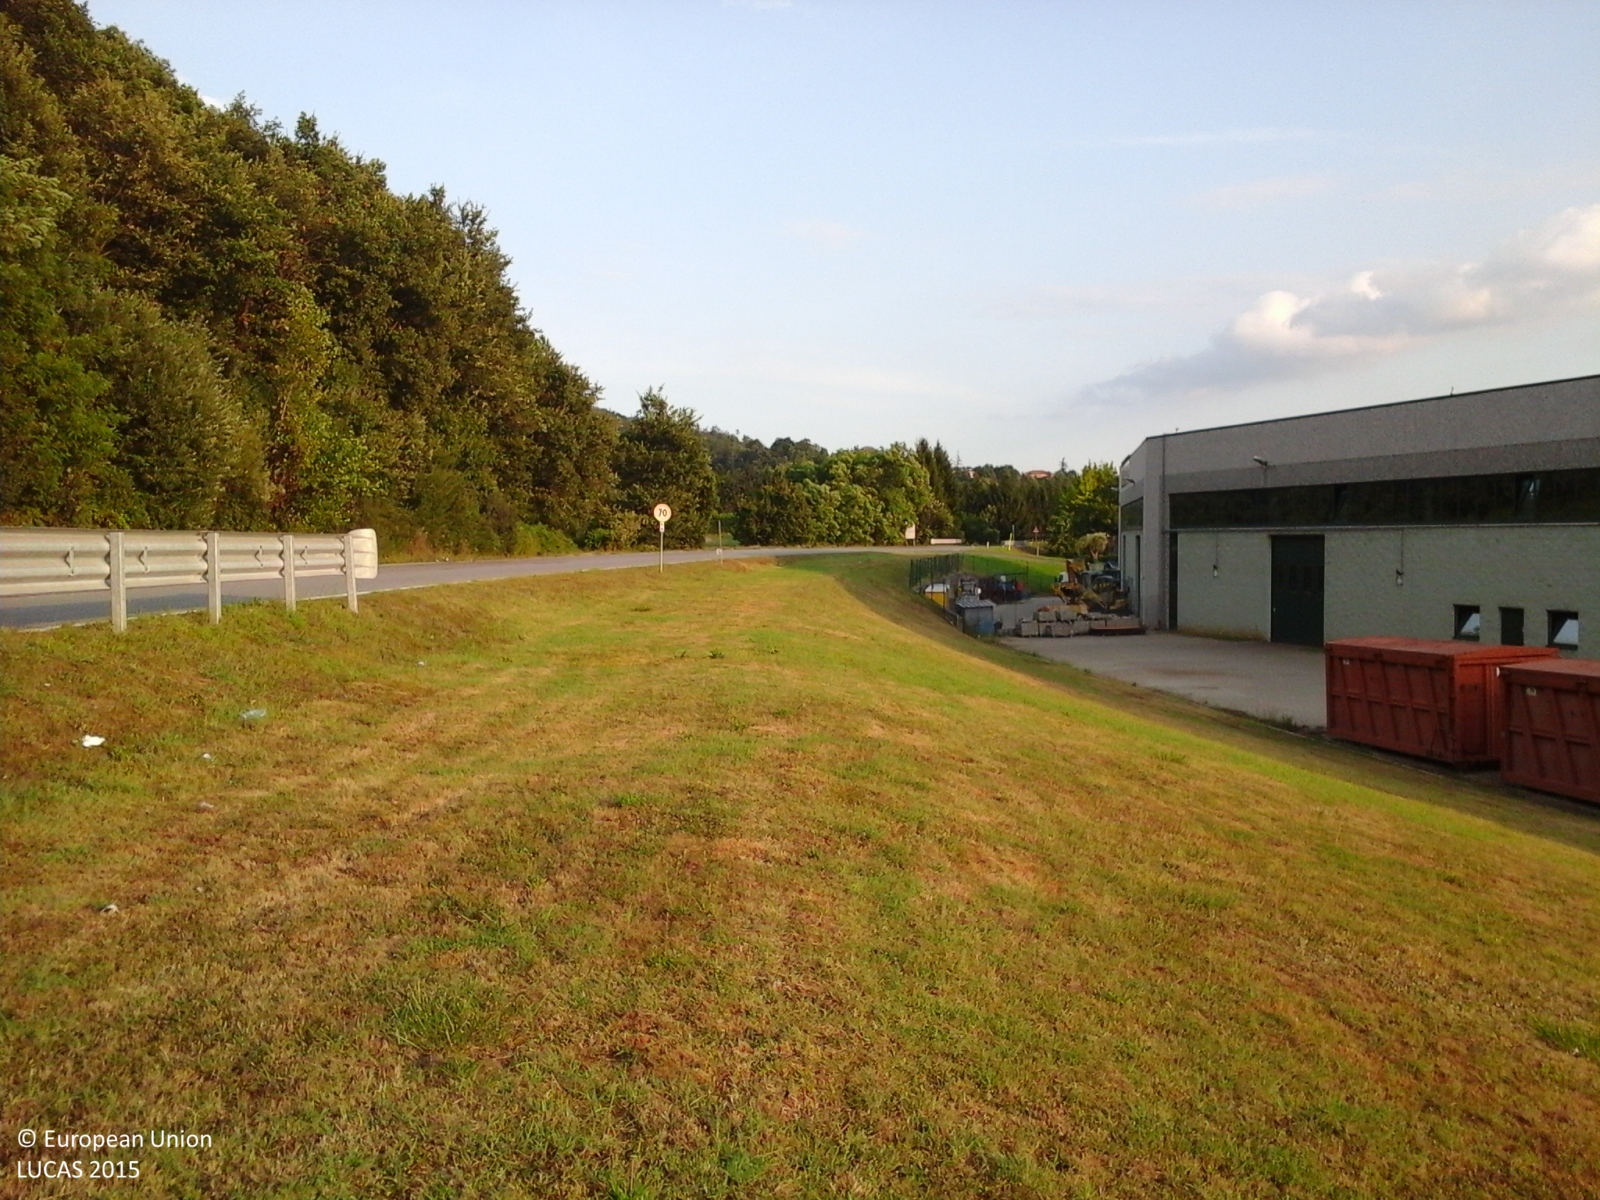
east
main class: Grassland
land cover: Grassland without tree/shrub cover
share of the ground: > 75 %
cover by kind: herbaceous plants 100 %
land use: Semi-natural and natural areas not in use
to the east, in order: Grassland without tree/shrub cover; Paved roads, cycling and walking lanes; Broadleaved woodland
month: July
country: IT
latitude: 44.4085
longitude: 8.2834
